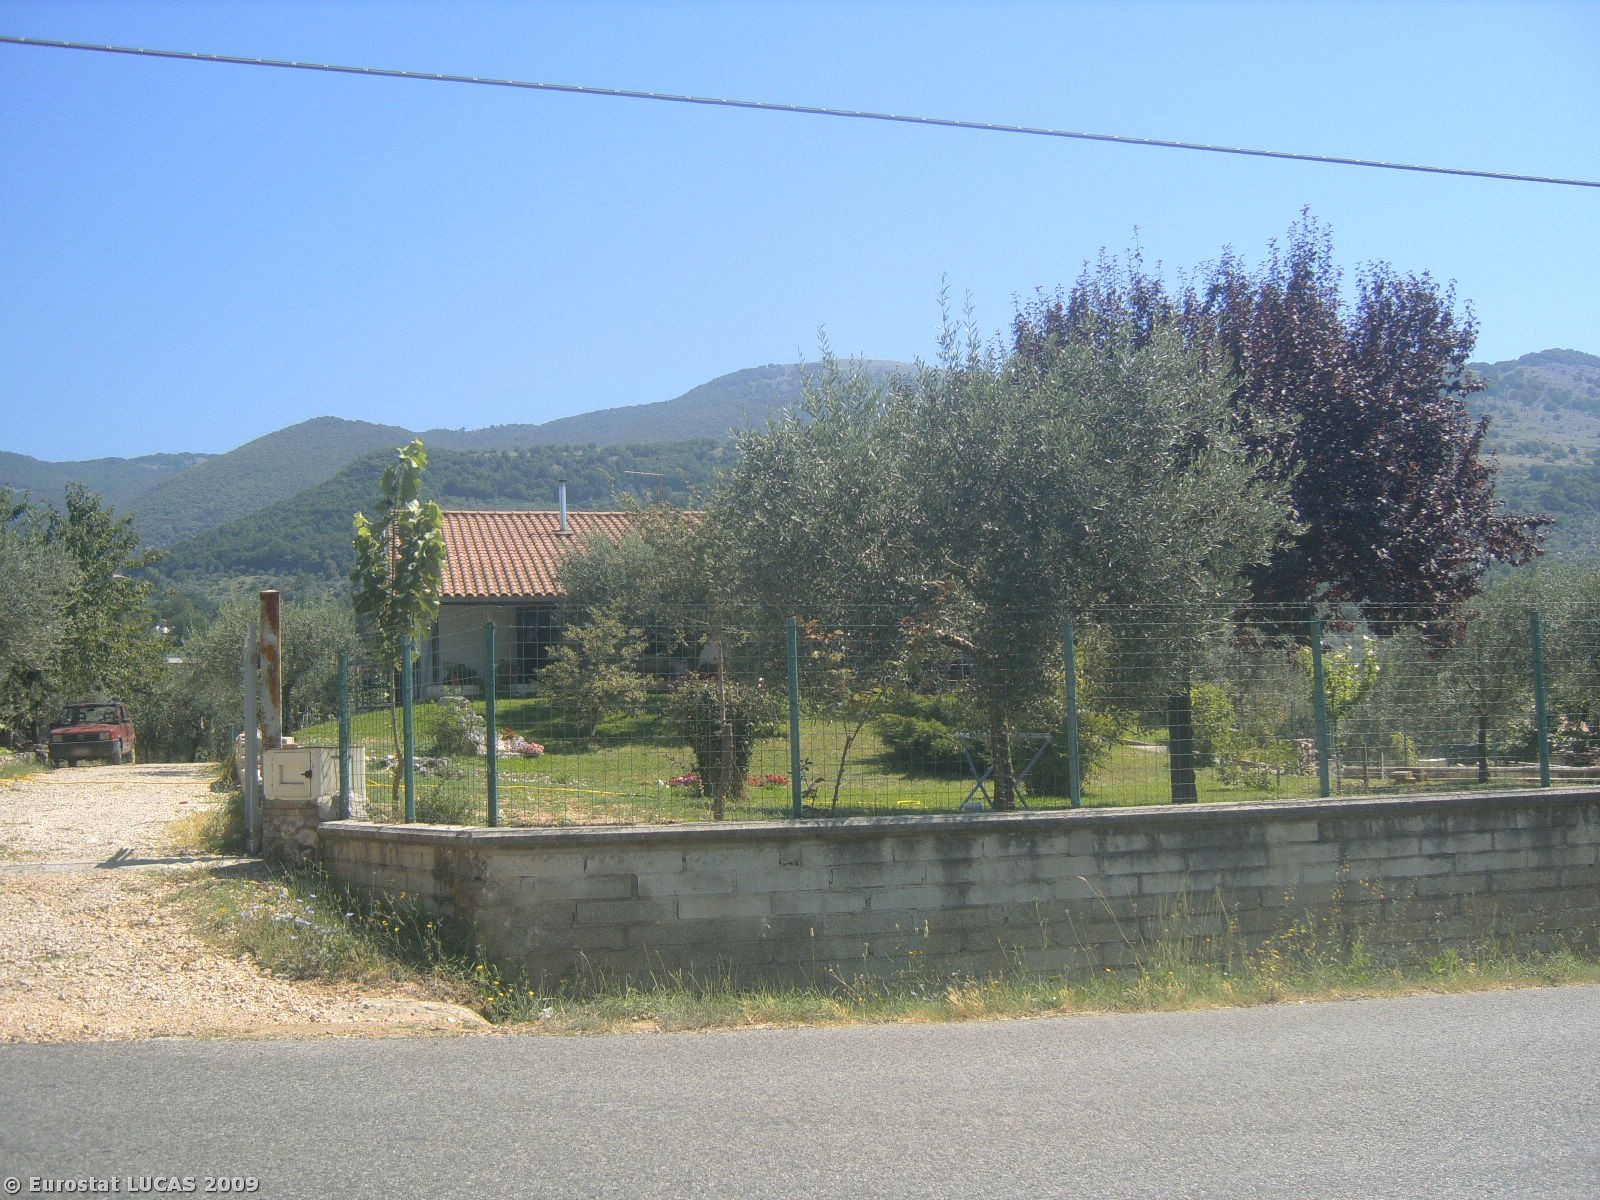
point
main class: Grassland
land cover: Grassland with sparse tree/shrub cover
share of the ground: 25 - 50 %
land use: Residential
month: July
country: IT
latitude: 41.7121
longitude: 13.3648
